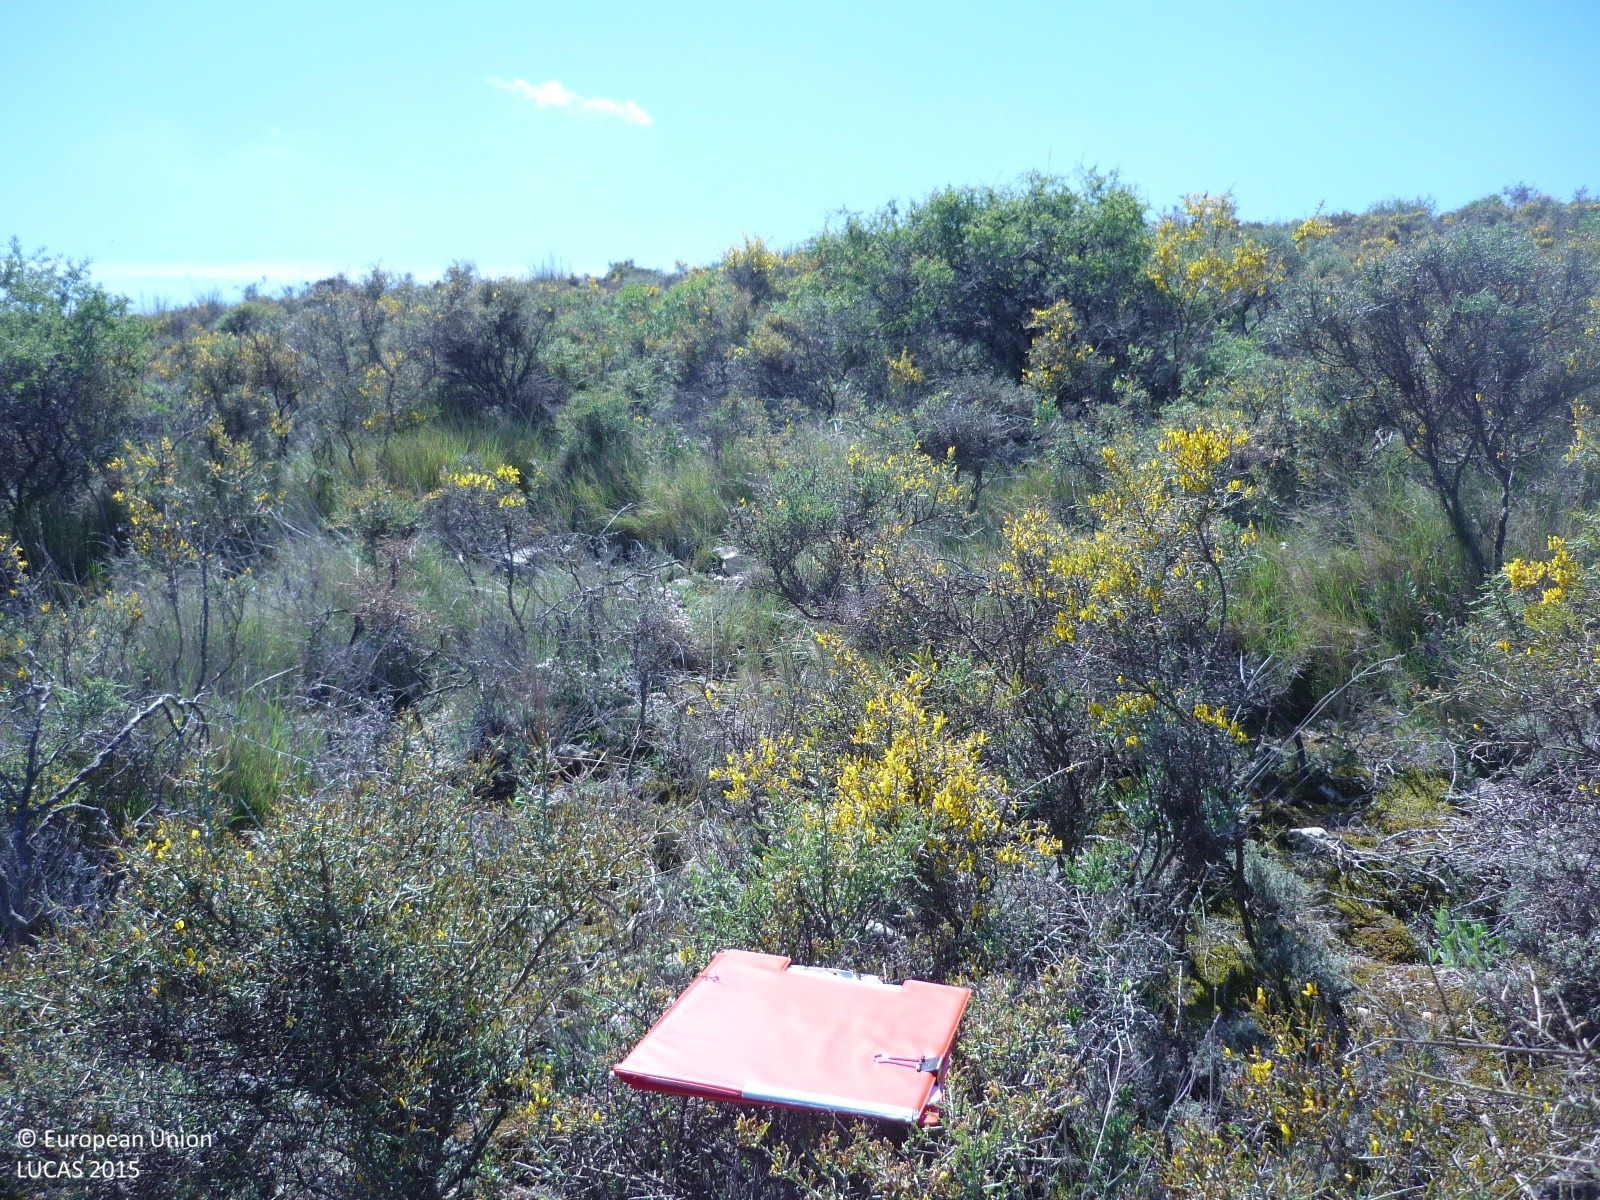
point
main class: Shrubland
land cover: Shrubland without tree cover
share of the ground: > 75 %
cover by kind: shrubs 75 %, herbaceous plants 25 %
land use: Semi-natural and natural areas not in use
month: April
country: ES
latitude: 40.7681
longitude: -3.5575
